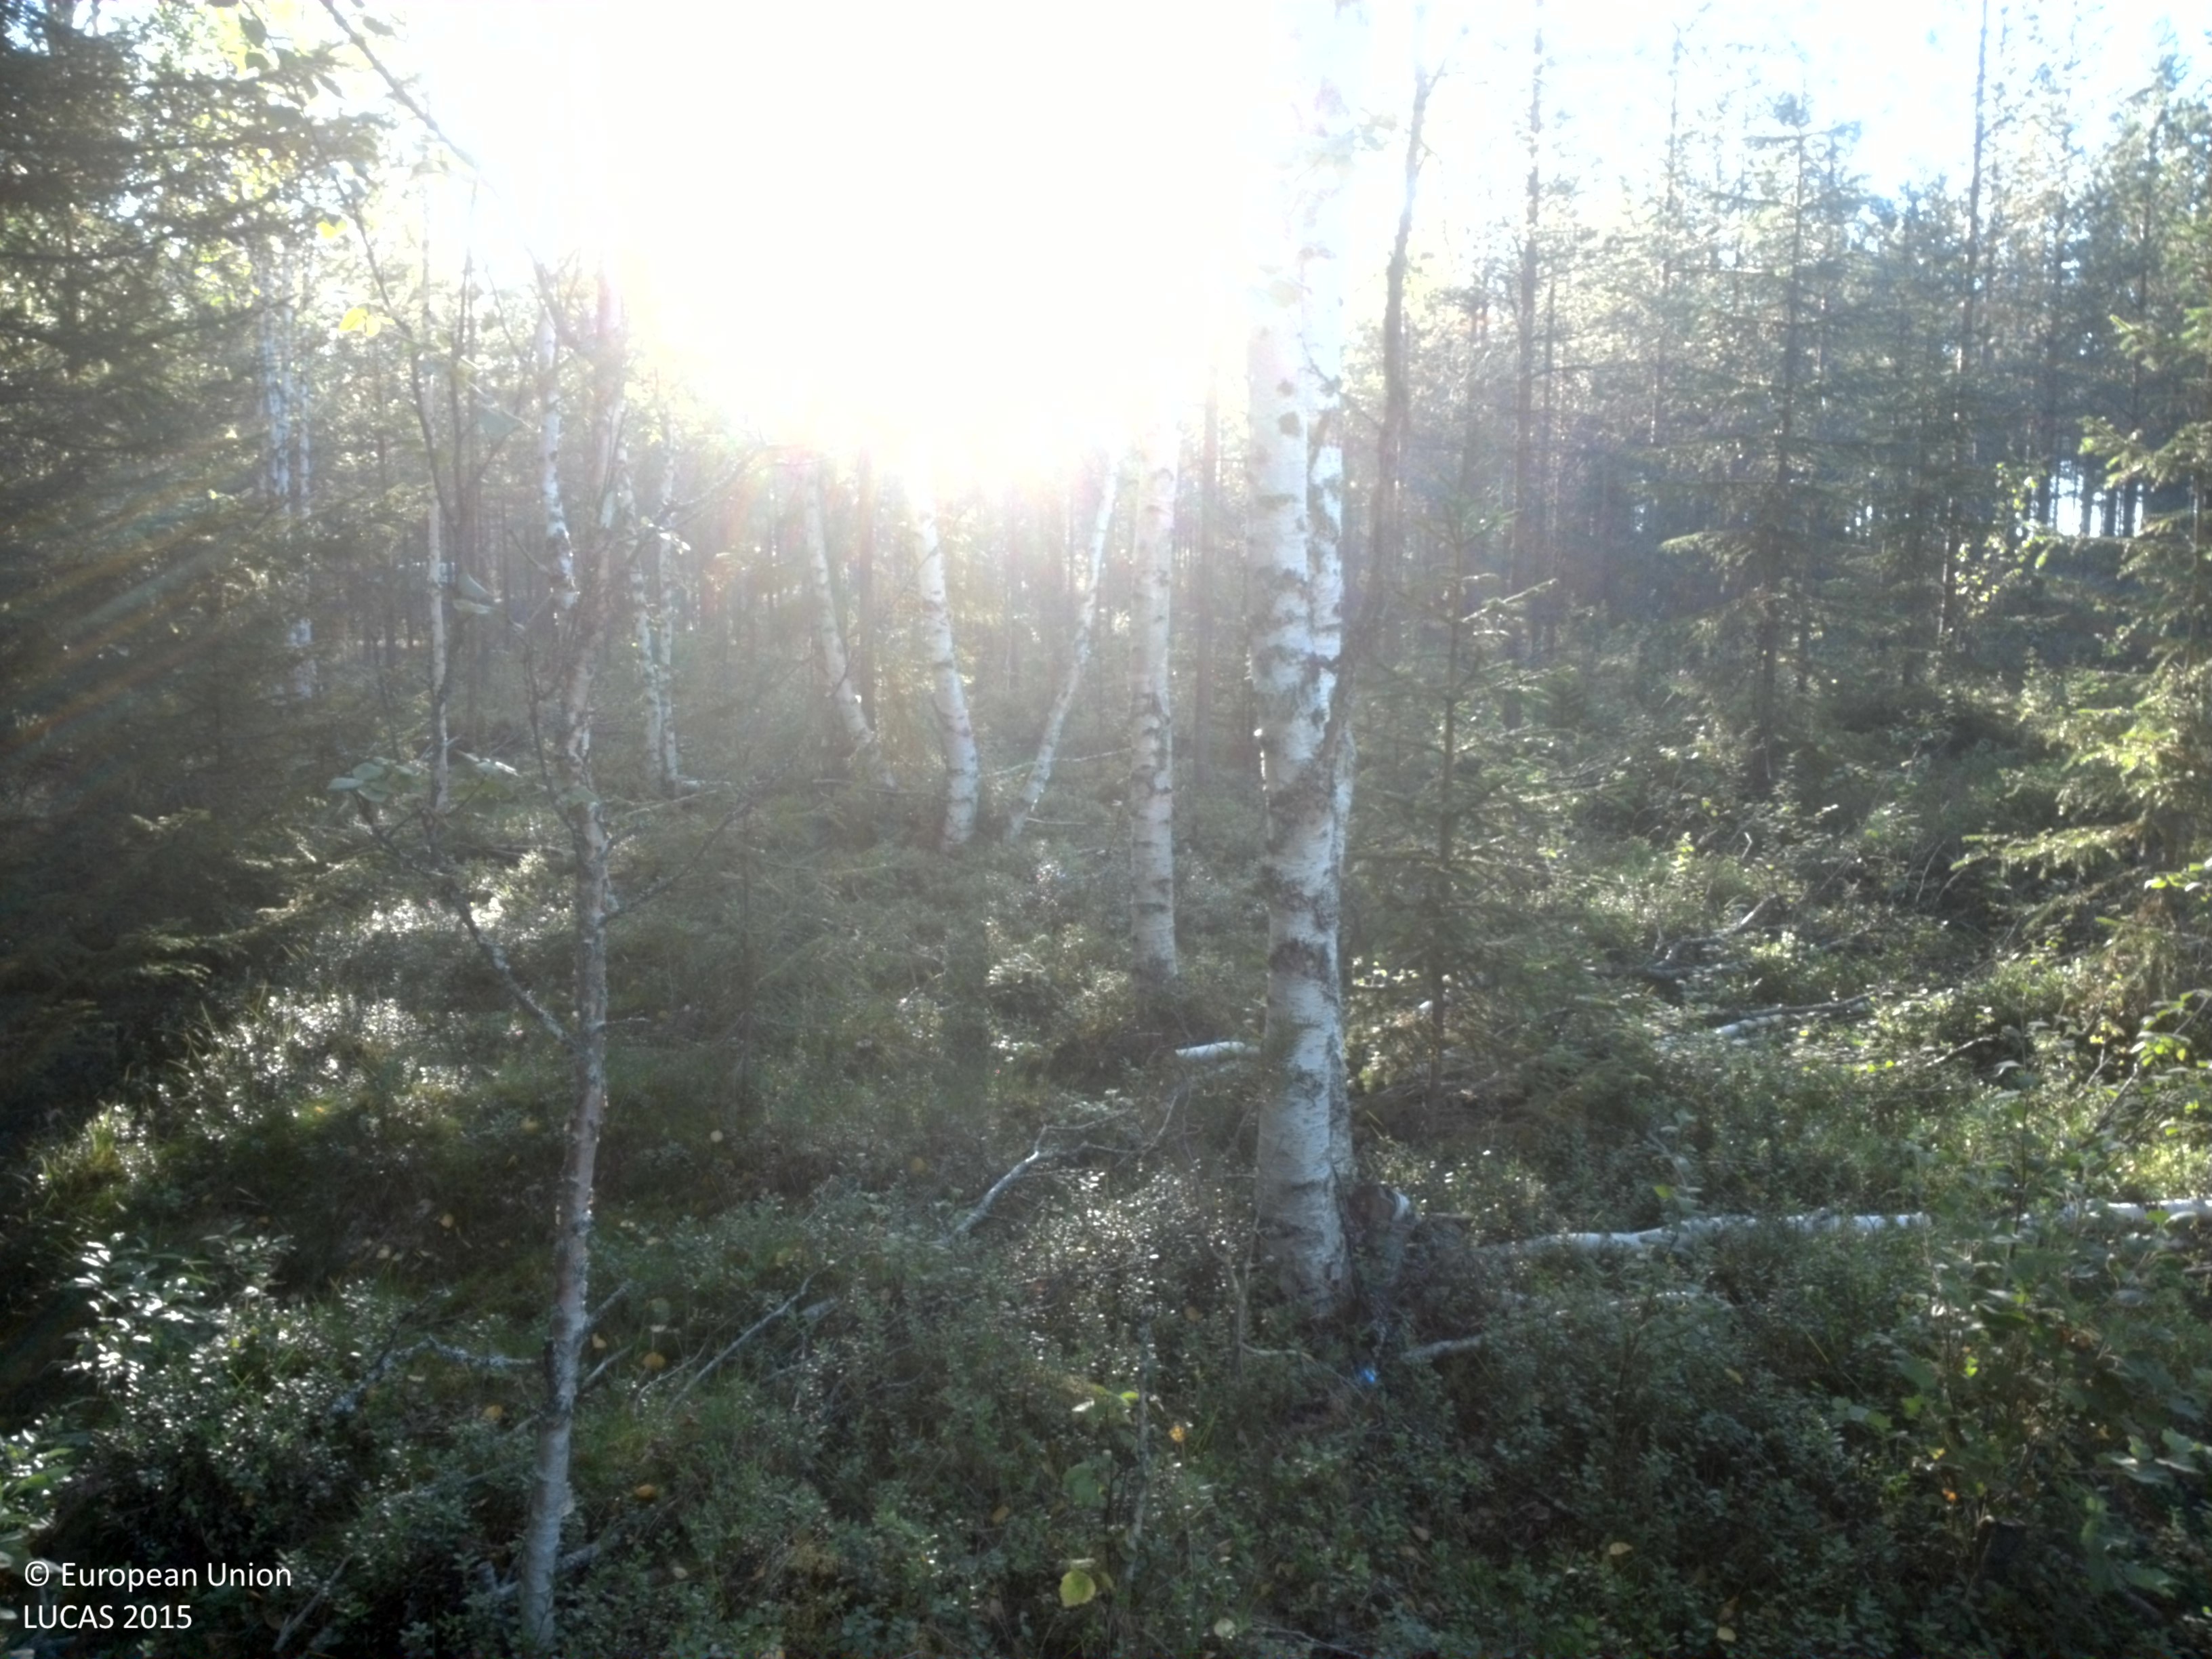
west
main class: Woodland
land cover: Pine dominated mixed woodland
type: boreal forest
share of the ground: 50 - 75 %
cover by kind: coniferous forest trees 45 %, shrubs 35 %, broadleaved forest trees 15 %, lichens and mosses 5 %
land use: Forestry
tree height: > 5 m
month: August
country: SE
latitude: 64.6165
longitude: 18.3092
